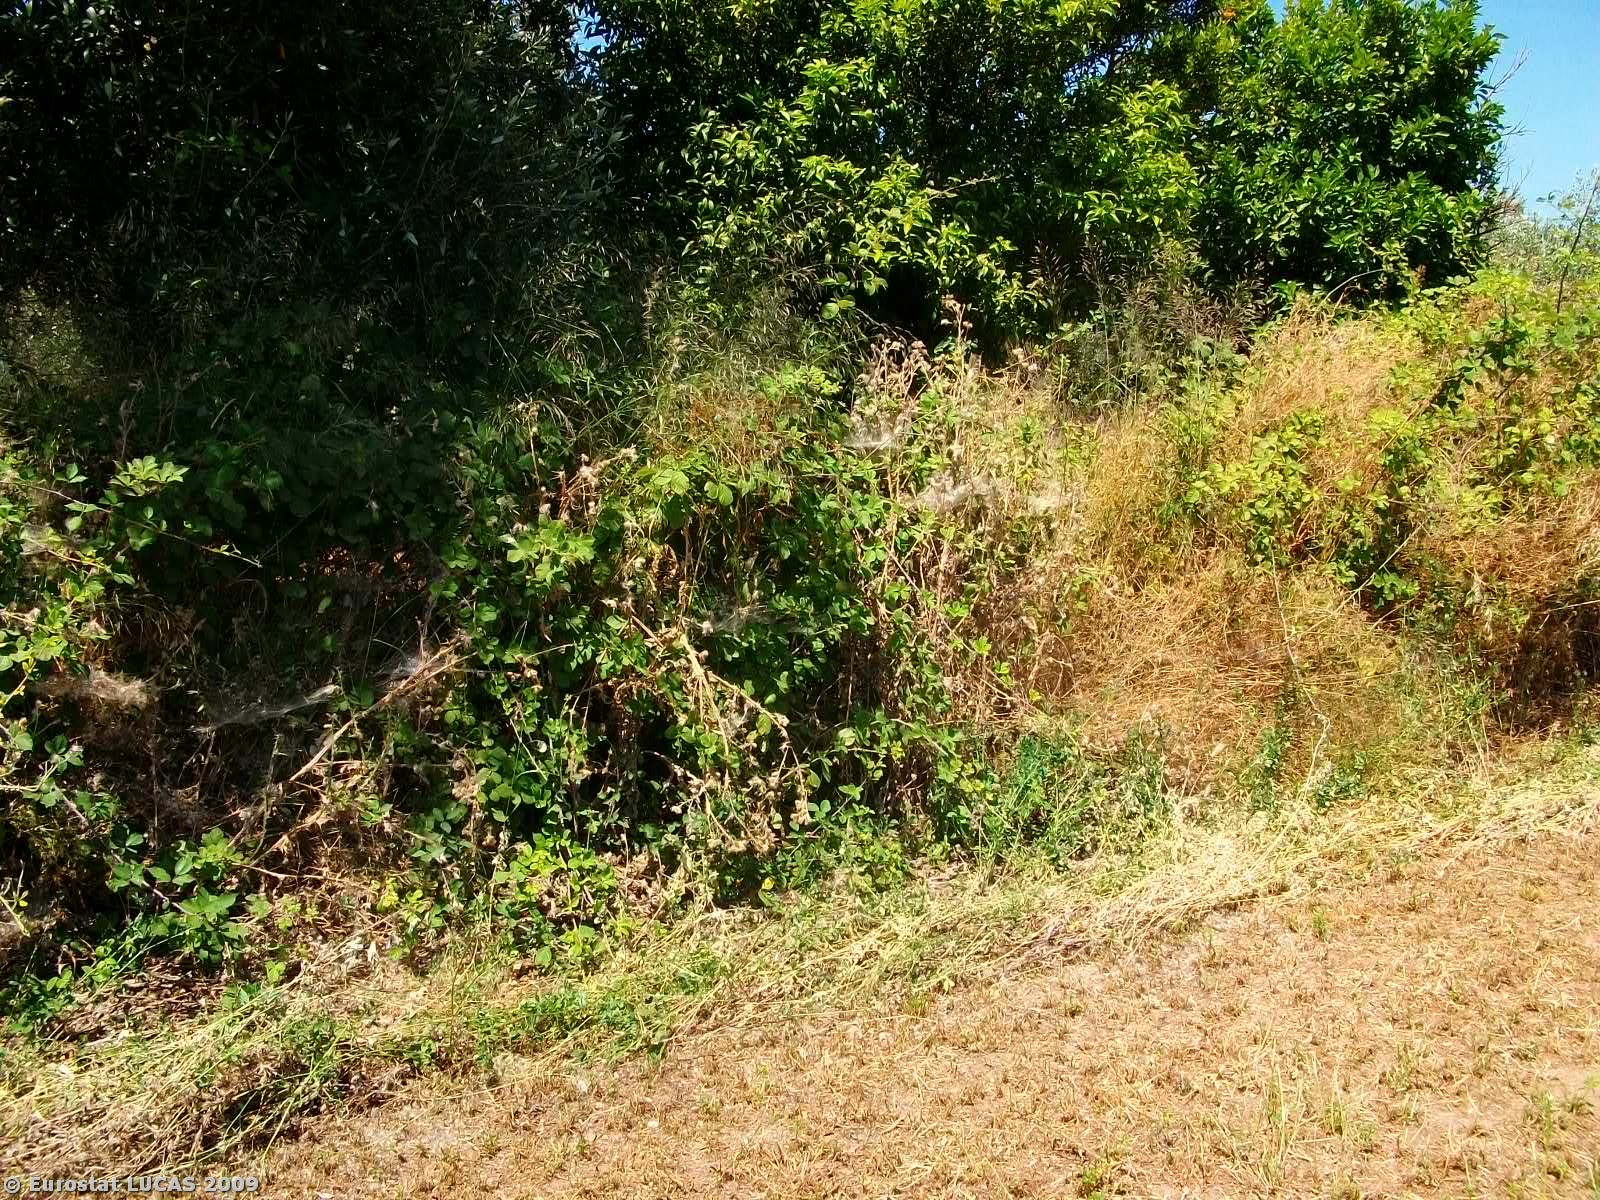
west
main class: Cropland
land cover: Lucerne
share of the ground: > 75 %
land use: Agriculture (excluding fallow land and kitchen gardens)
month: June
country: GR
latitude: 38.5733
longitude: 21.4361
